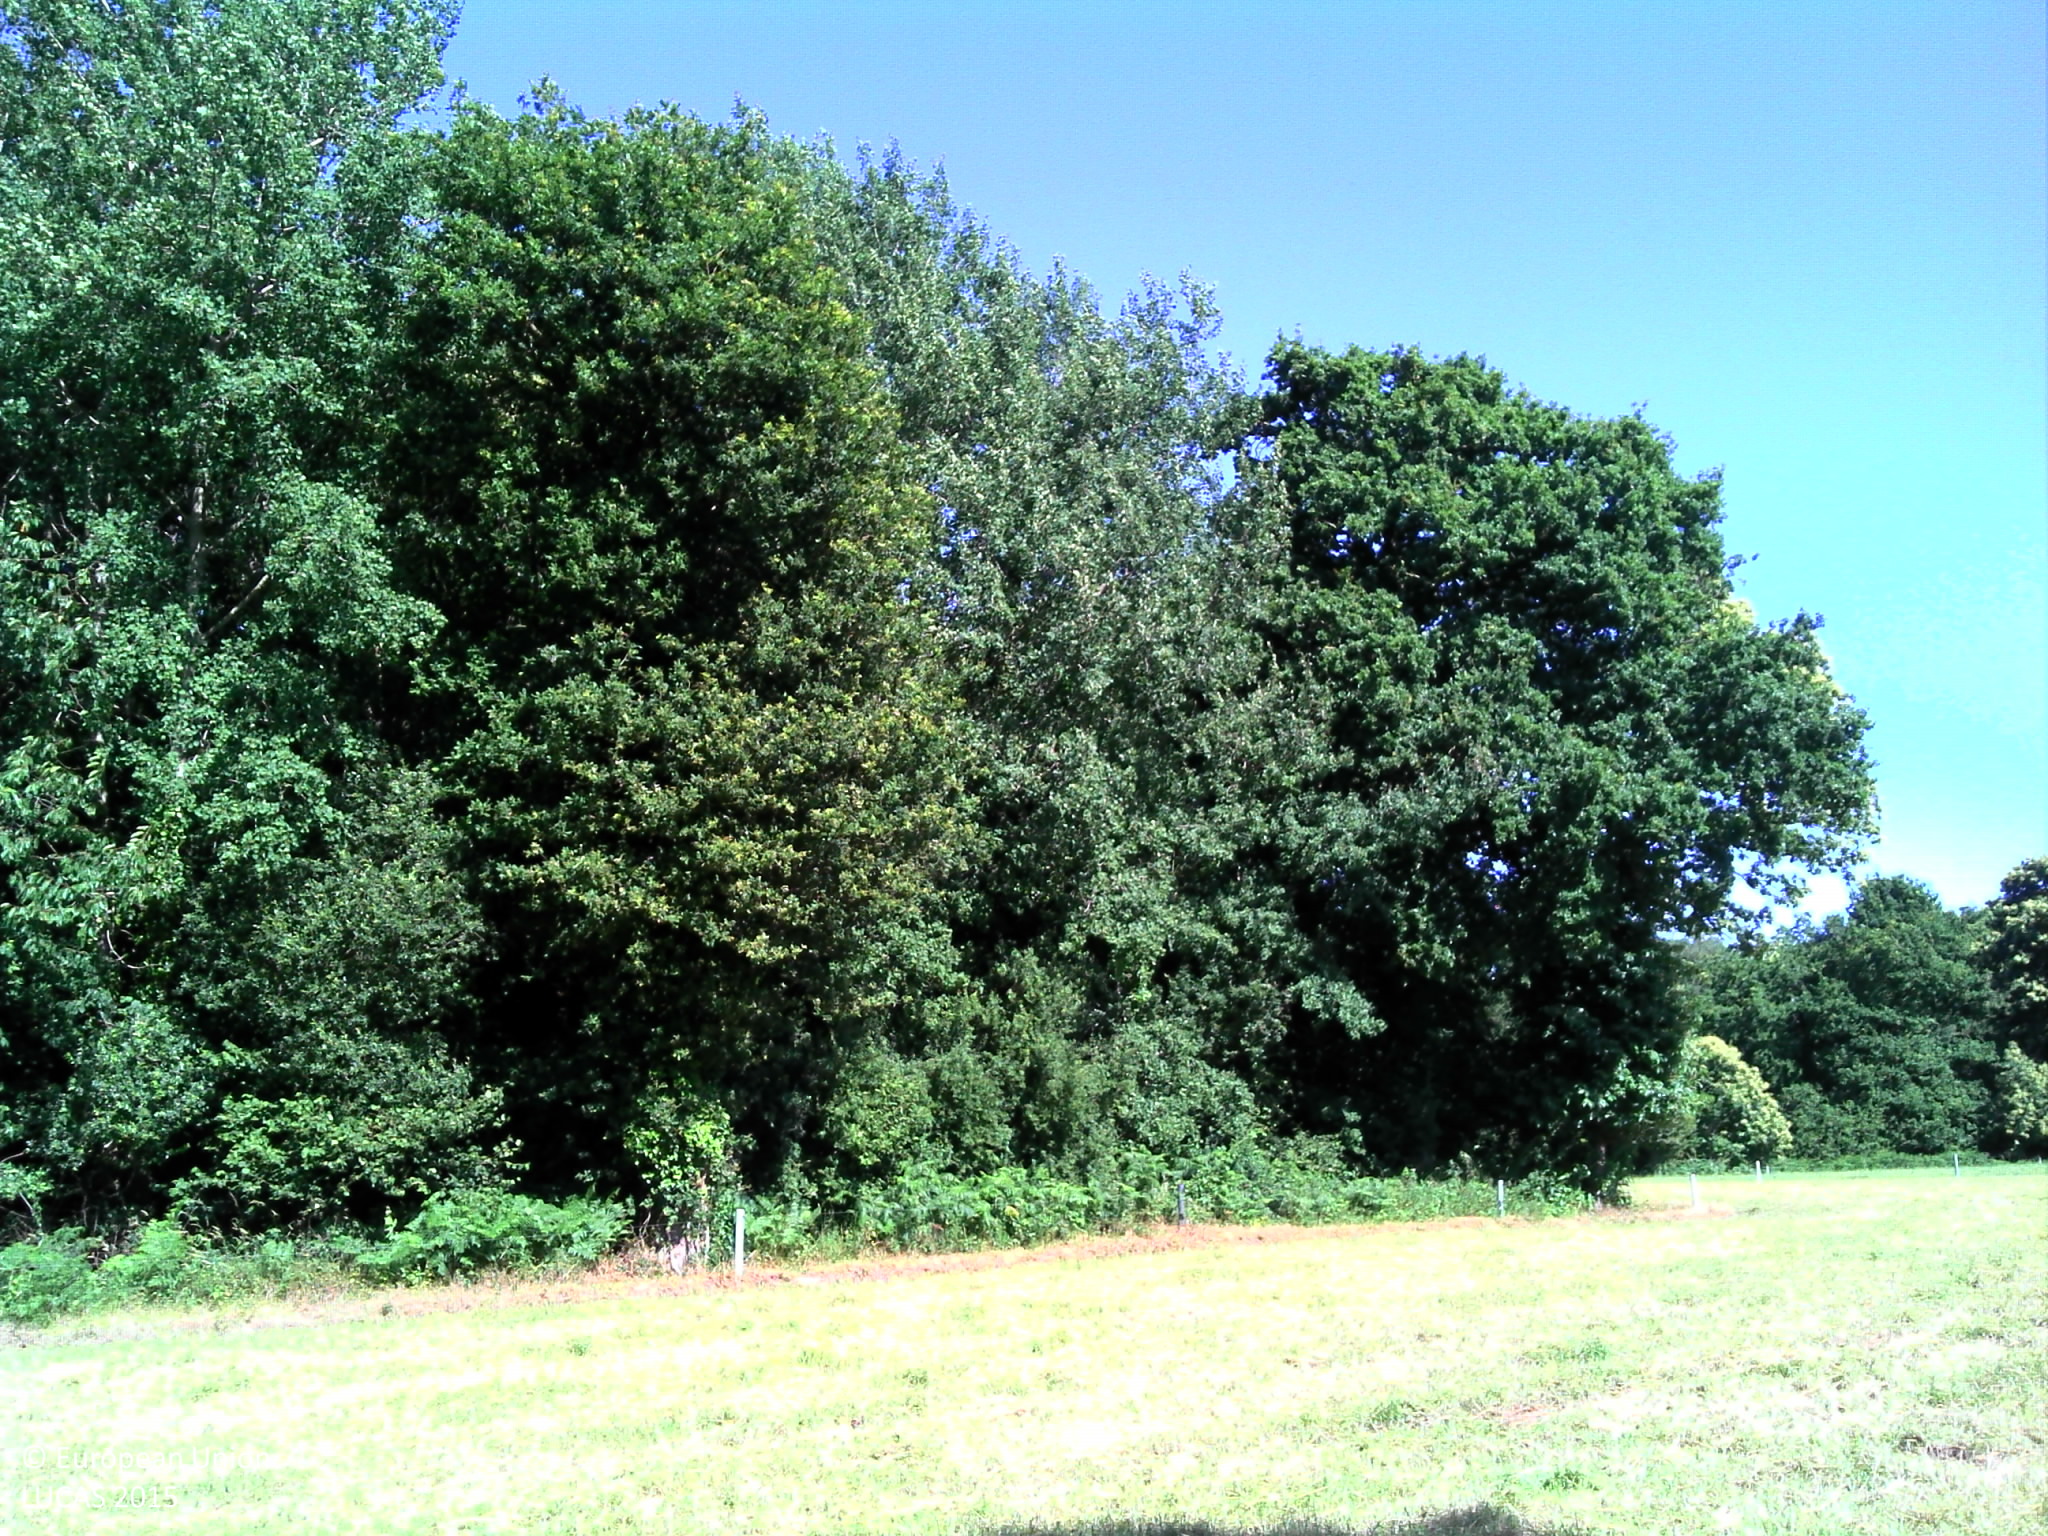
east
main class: Grassland
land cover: Grassland without tree/shrub cover
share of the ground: > 75 %
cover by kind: herbaceous plants 100 %
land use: Agriculture (excluding fallow land and kitchen gardens)
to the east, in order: Grassland without tree/shrub cover; Fences; Broadleaved woodland; Rivers and streams; Broadleaved woodland
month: July
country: FR
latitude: 48.3865
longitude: -2.1414
